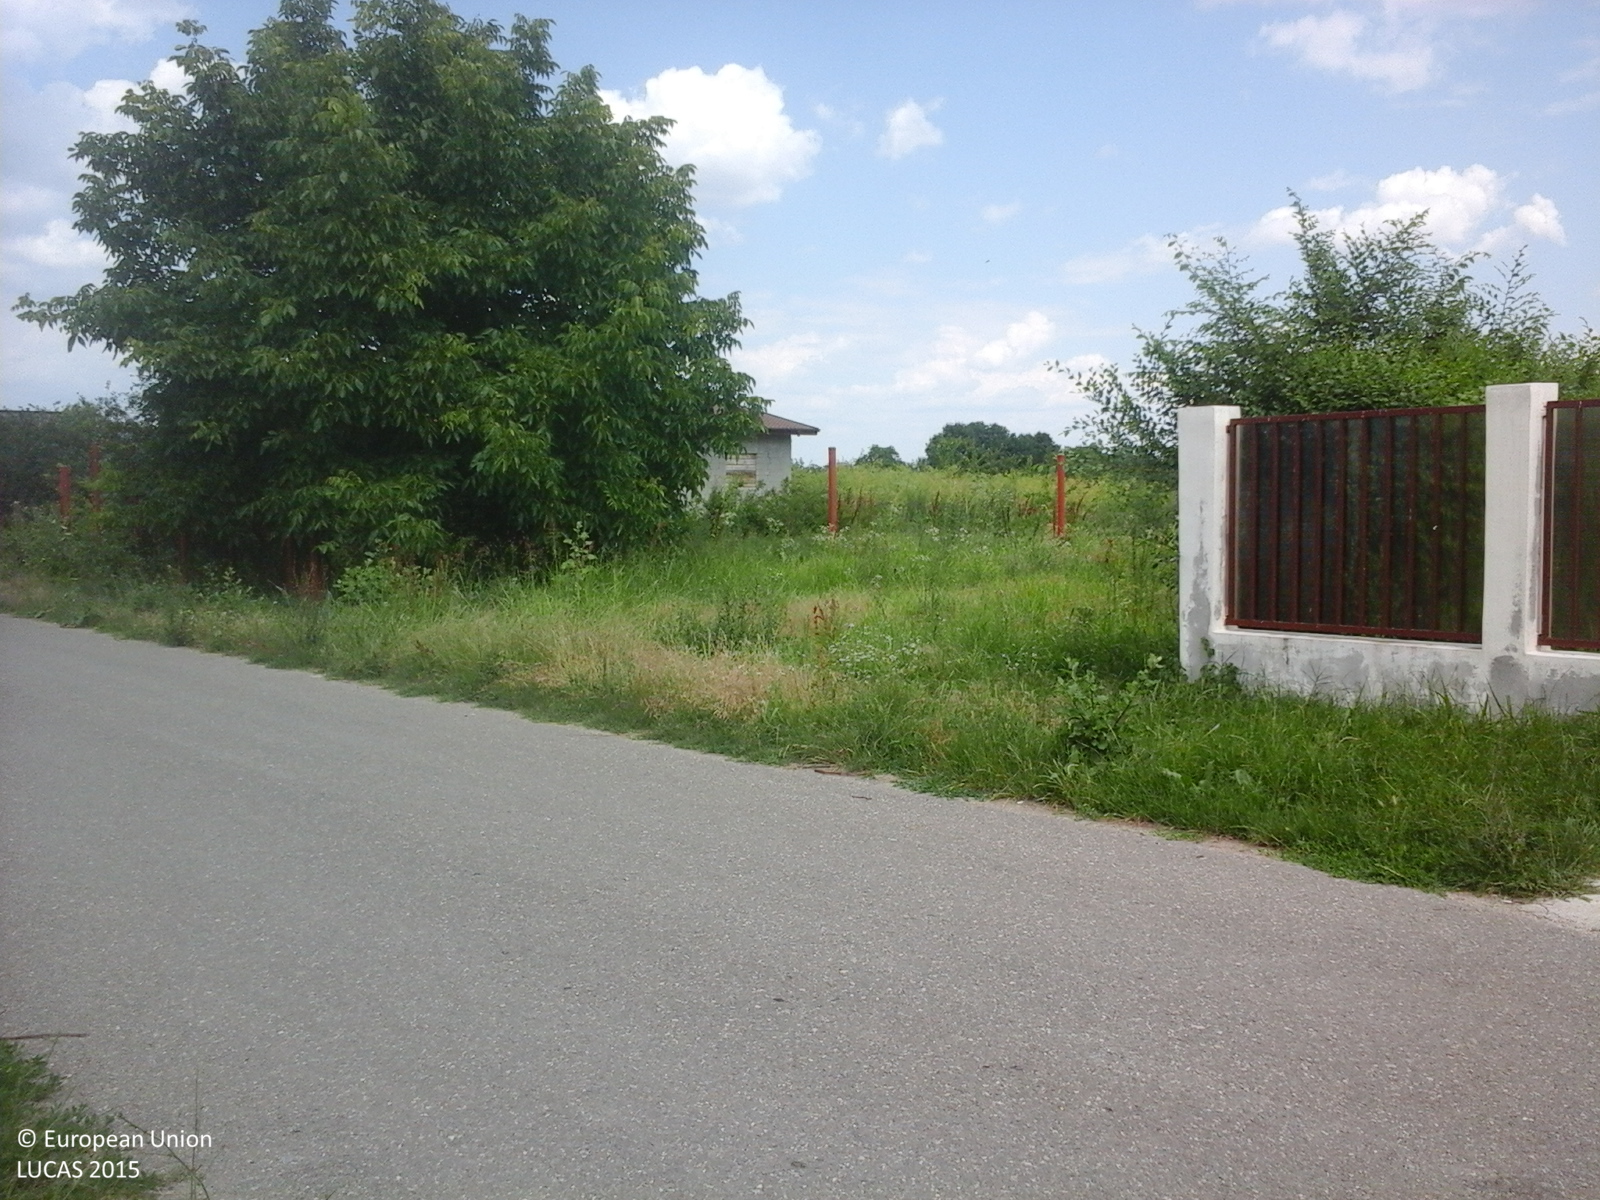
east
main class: Grassland
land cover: Grassland with sparse tree/shrub cover
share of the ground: > 75 %
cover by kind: herbaceous plants 95 %, broadleaved forest trees 5 %
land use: Agriculture (excluding fallow land and kitchen gardens)
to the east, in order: Grassland with sparse tree/shrub cover; Electric lines; Paved roads, cycling and walking lanes; Spontaneously vegetated surfaces; Artificial constructions in urban areas; Apple fruit; Fences; Spontaneously vegetated surfaces; Single bushes/trees; Grassland without tree/shrub cover; Abandoned hedges; Grassland without tree/shrub cover; Abandoned hedges; Spontaneously vegetated surfaces; Broadleaved woodland
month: June
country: RO
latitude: 44.5983
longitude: 26.2745
